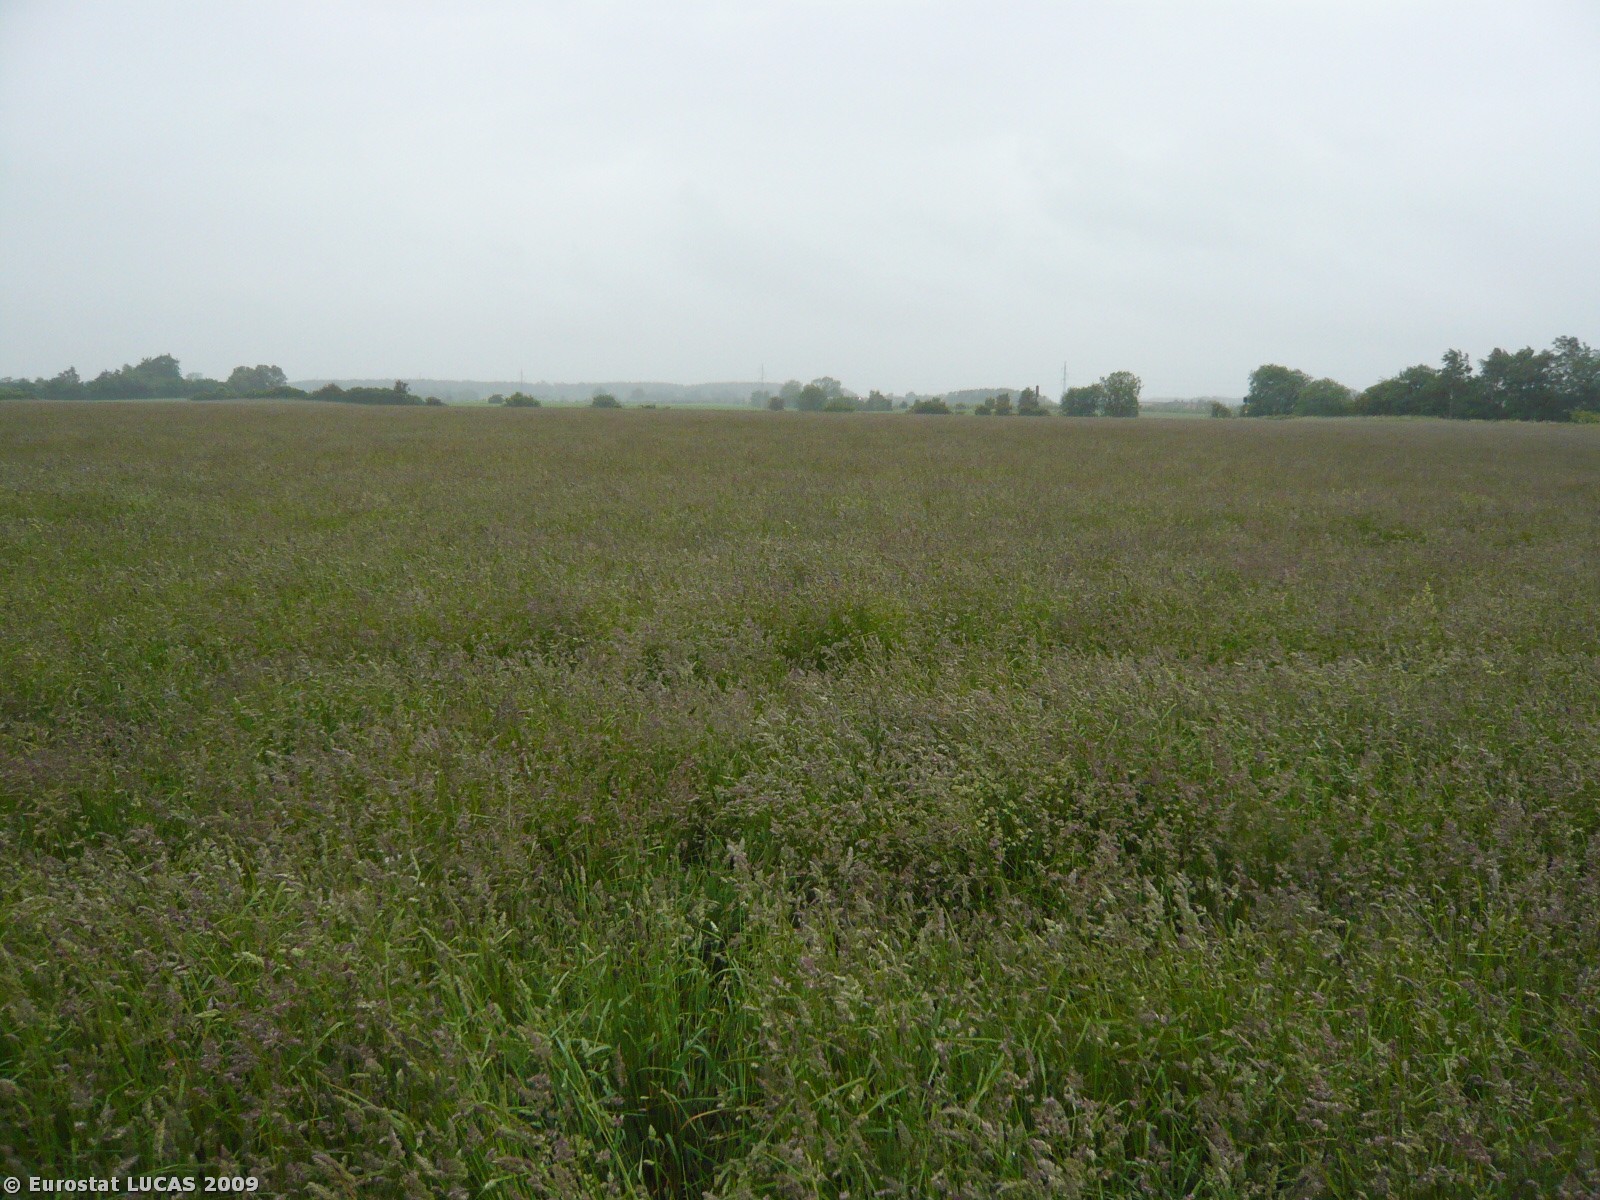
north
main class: Cropland
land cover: Temporary grasslands
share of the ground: > 75 %
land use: Agriculture (excluding fallow land and kitchen gardens)
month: June
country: DK
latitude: 54.8614
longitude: 11.8839
